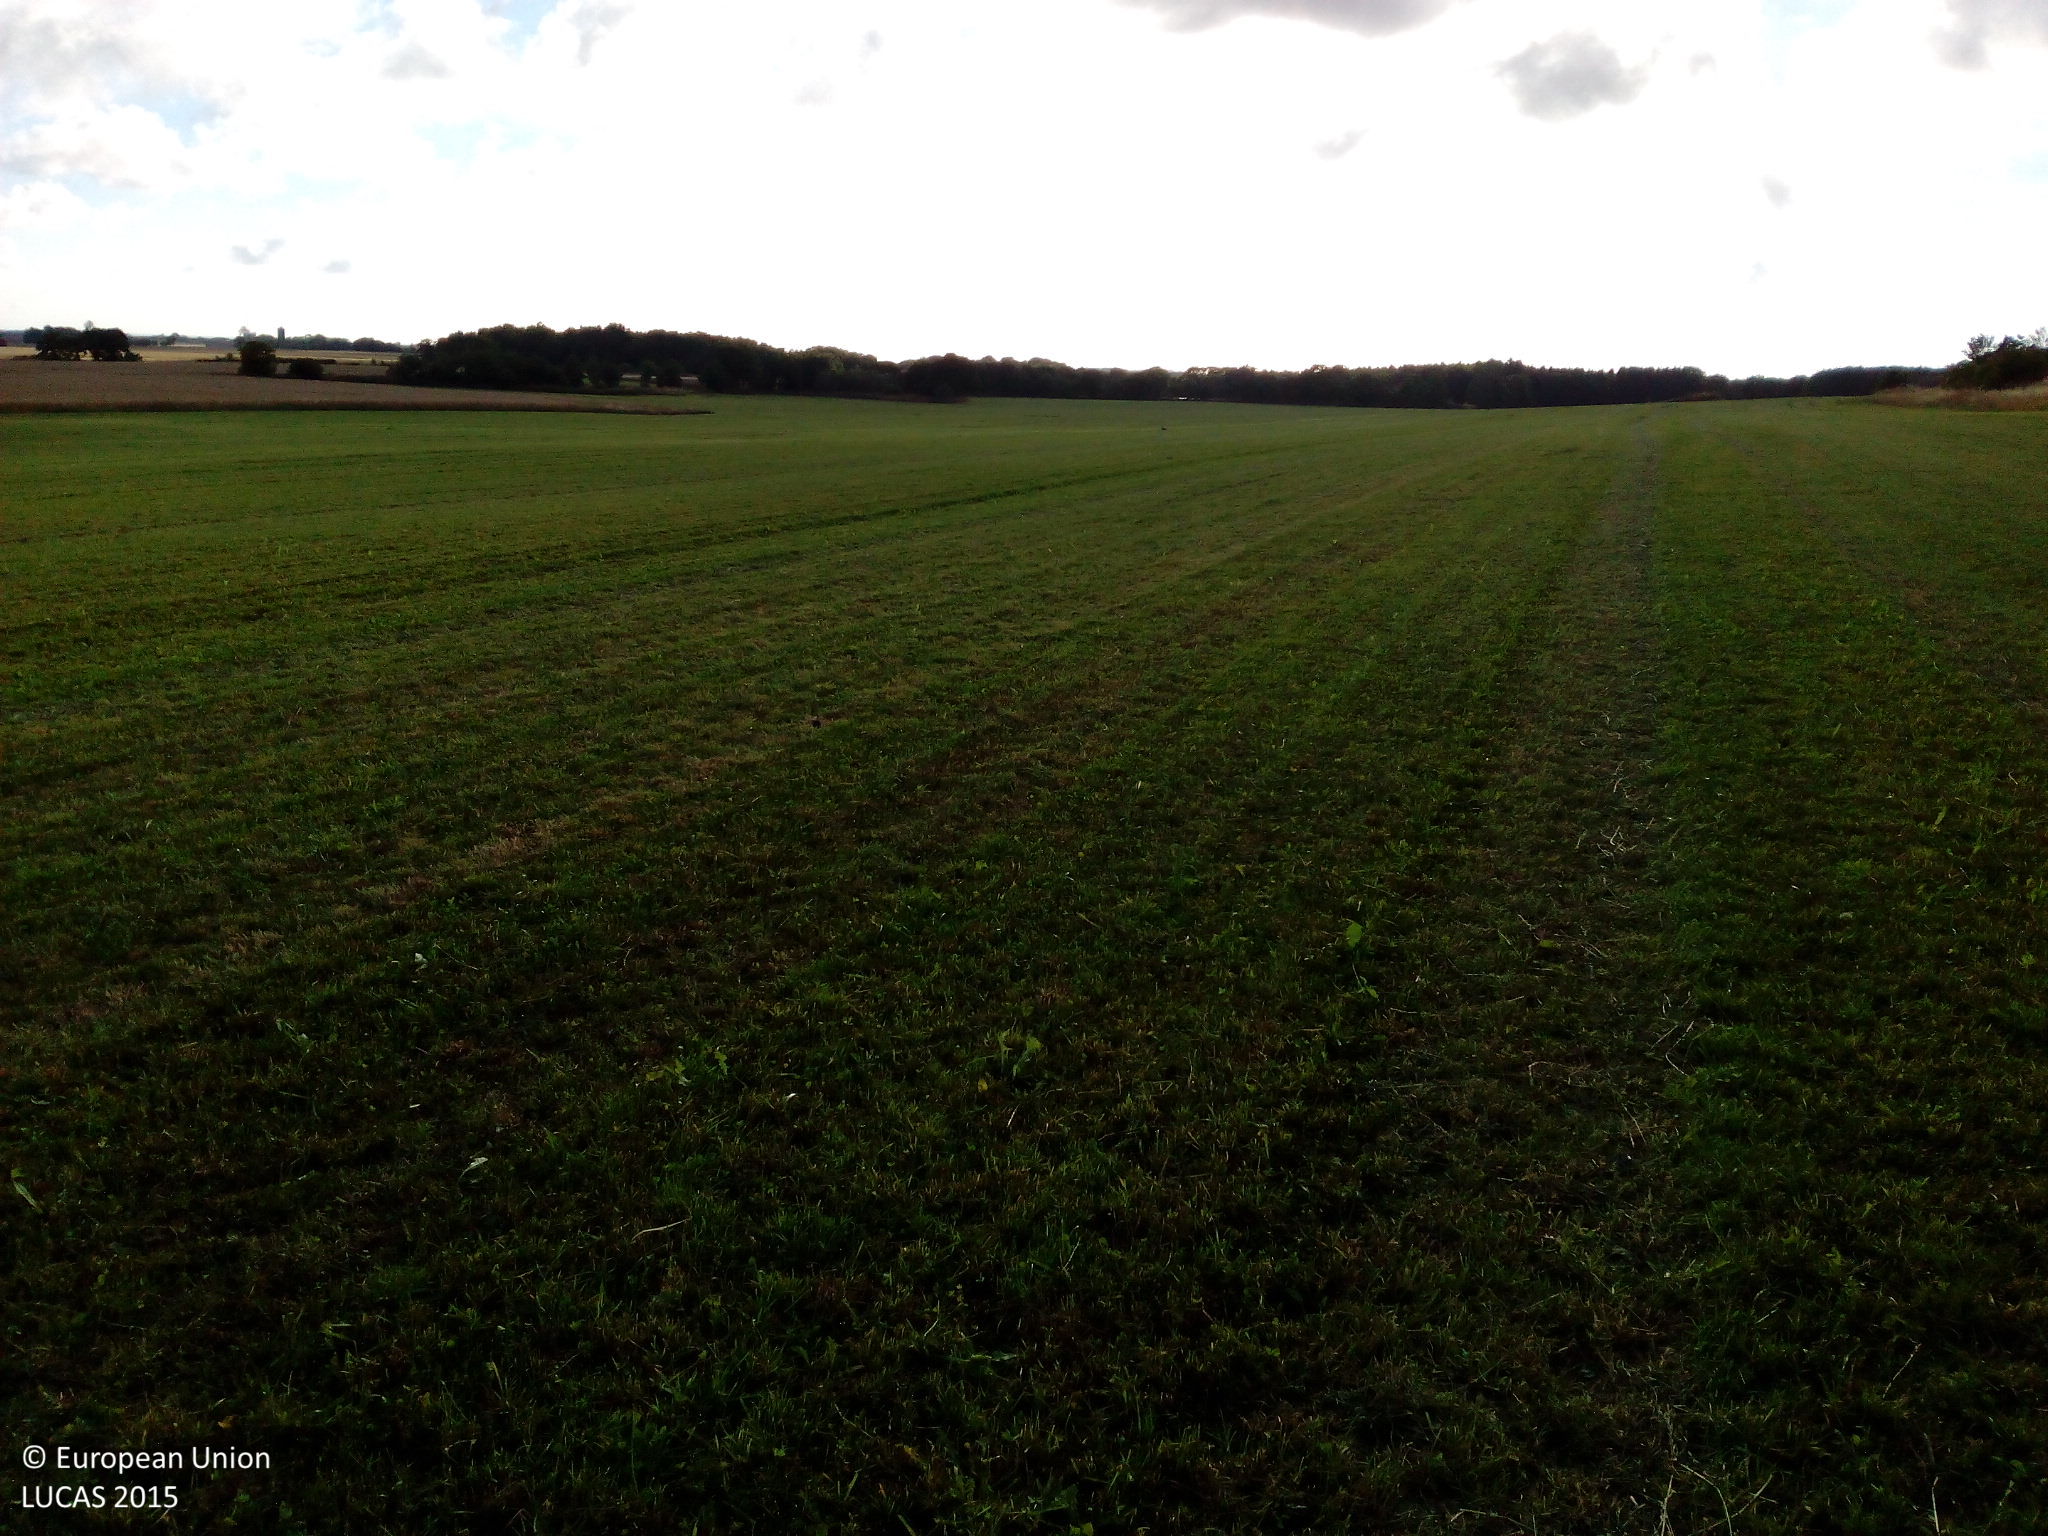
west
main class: Grassland
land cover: Grassland without tree/shrub cover
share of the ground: > 75 %
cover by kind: herbaceous plants 100 %
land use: Agriculture (excluding fallow land and kitchen gardens)
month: August
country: DK
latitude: 55.0639
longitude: 14.9953
